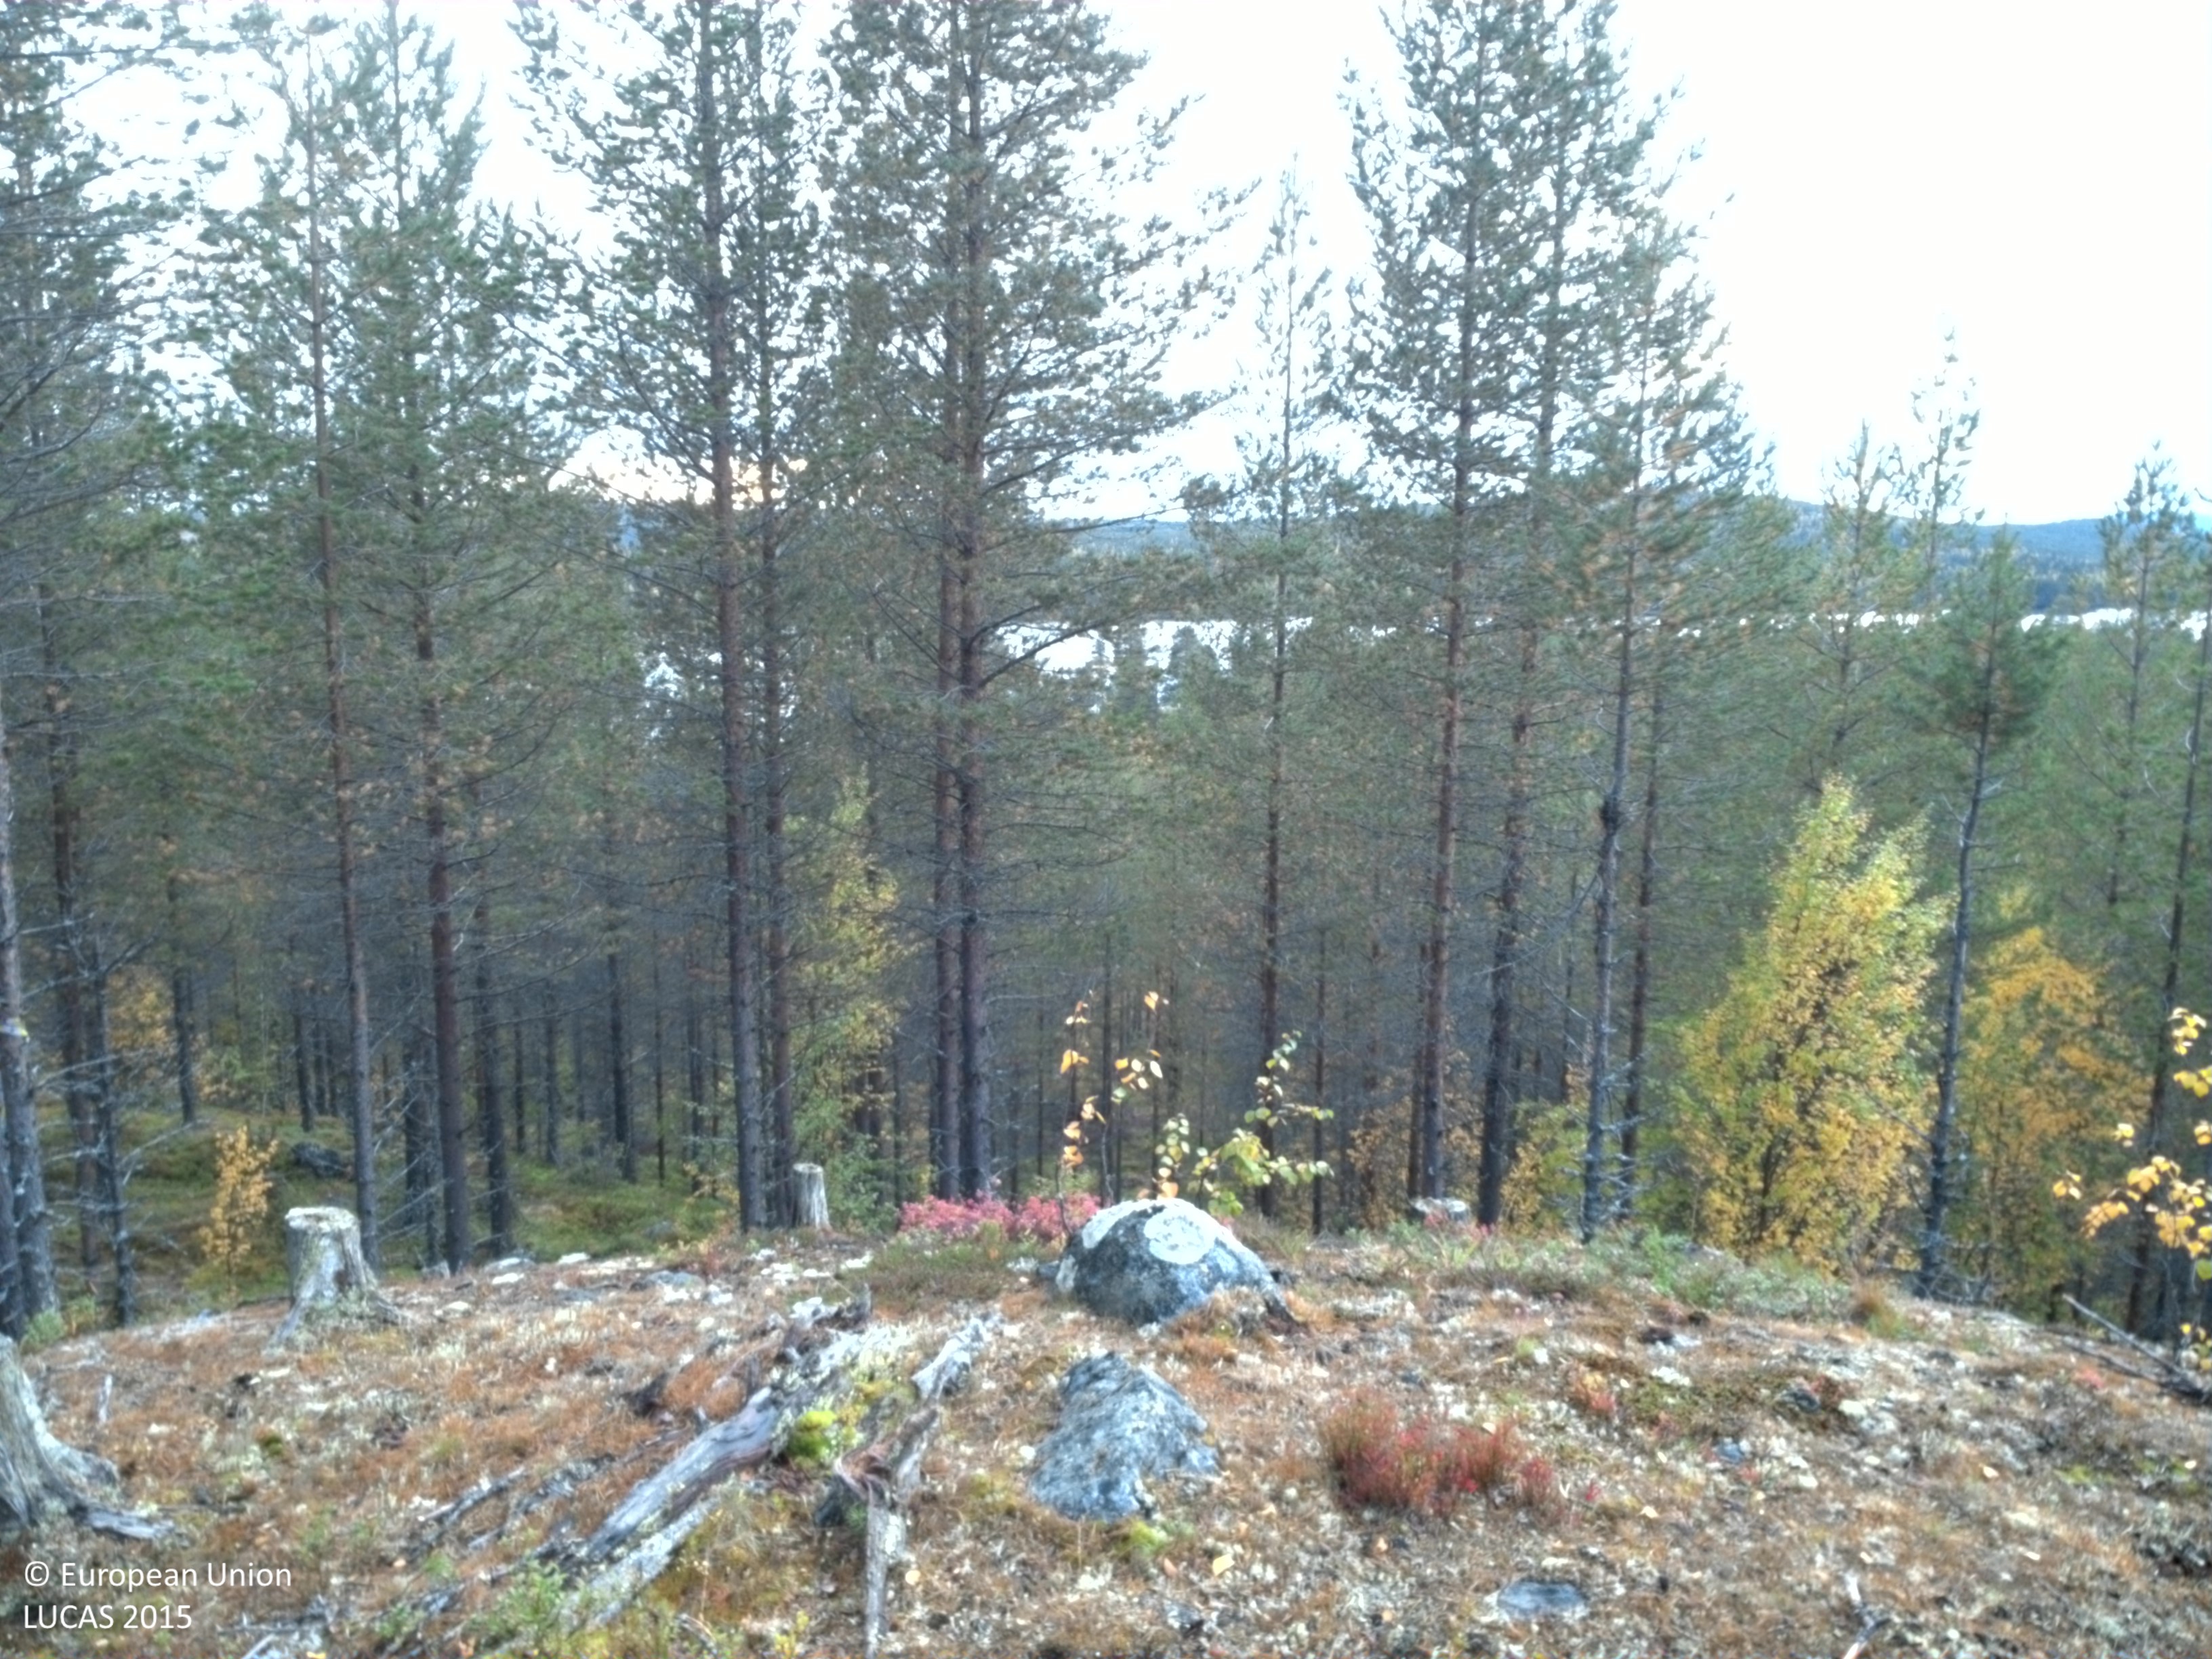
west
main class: Shrubland
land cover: Shrubland with sparse tree cover
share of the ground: 50 - 75 %
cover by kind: shrubs 60 %, lichens and mosses 35 %, broadleaved forest trees 5 %
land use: Forestry
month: September
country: SE
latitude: 65.1872
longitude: 16.5624
